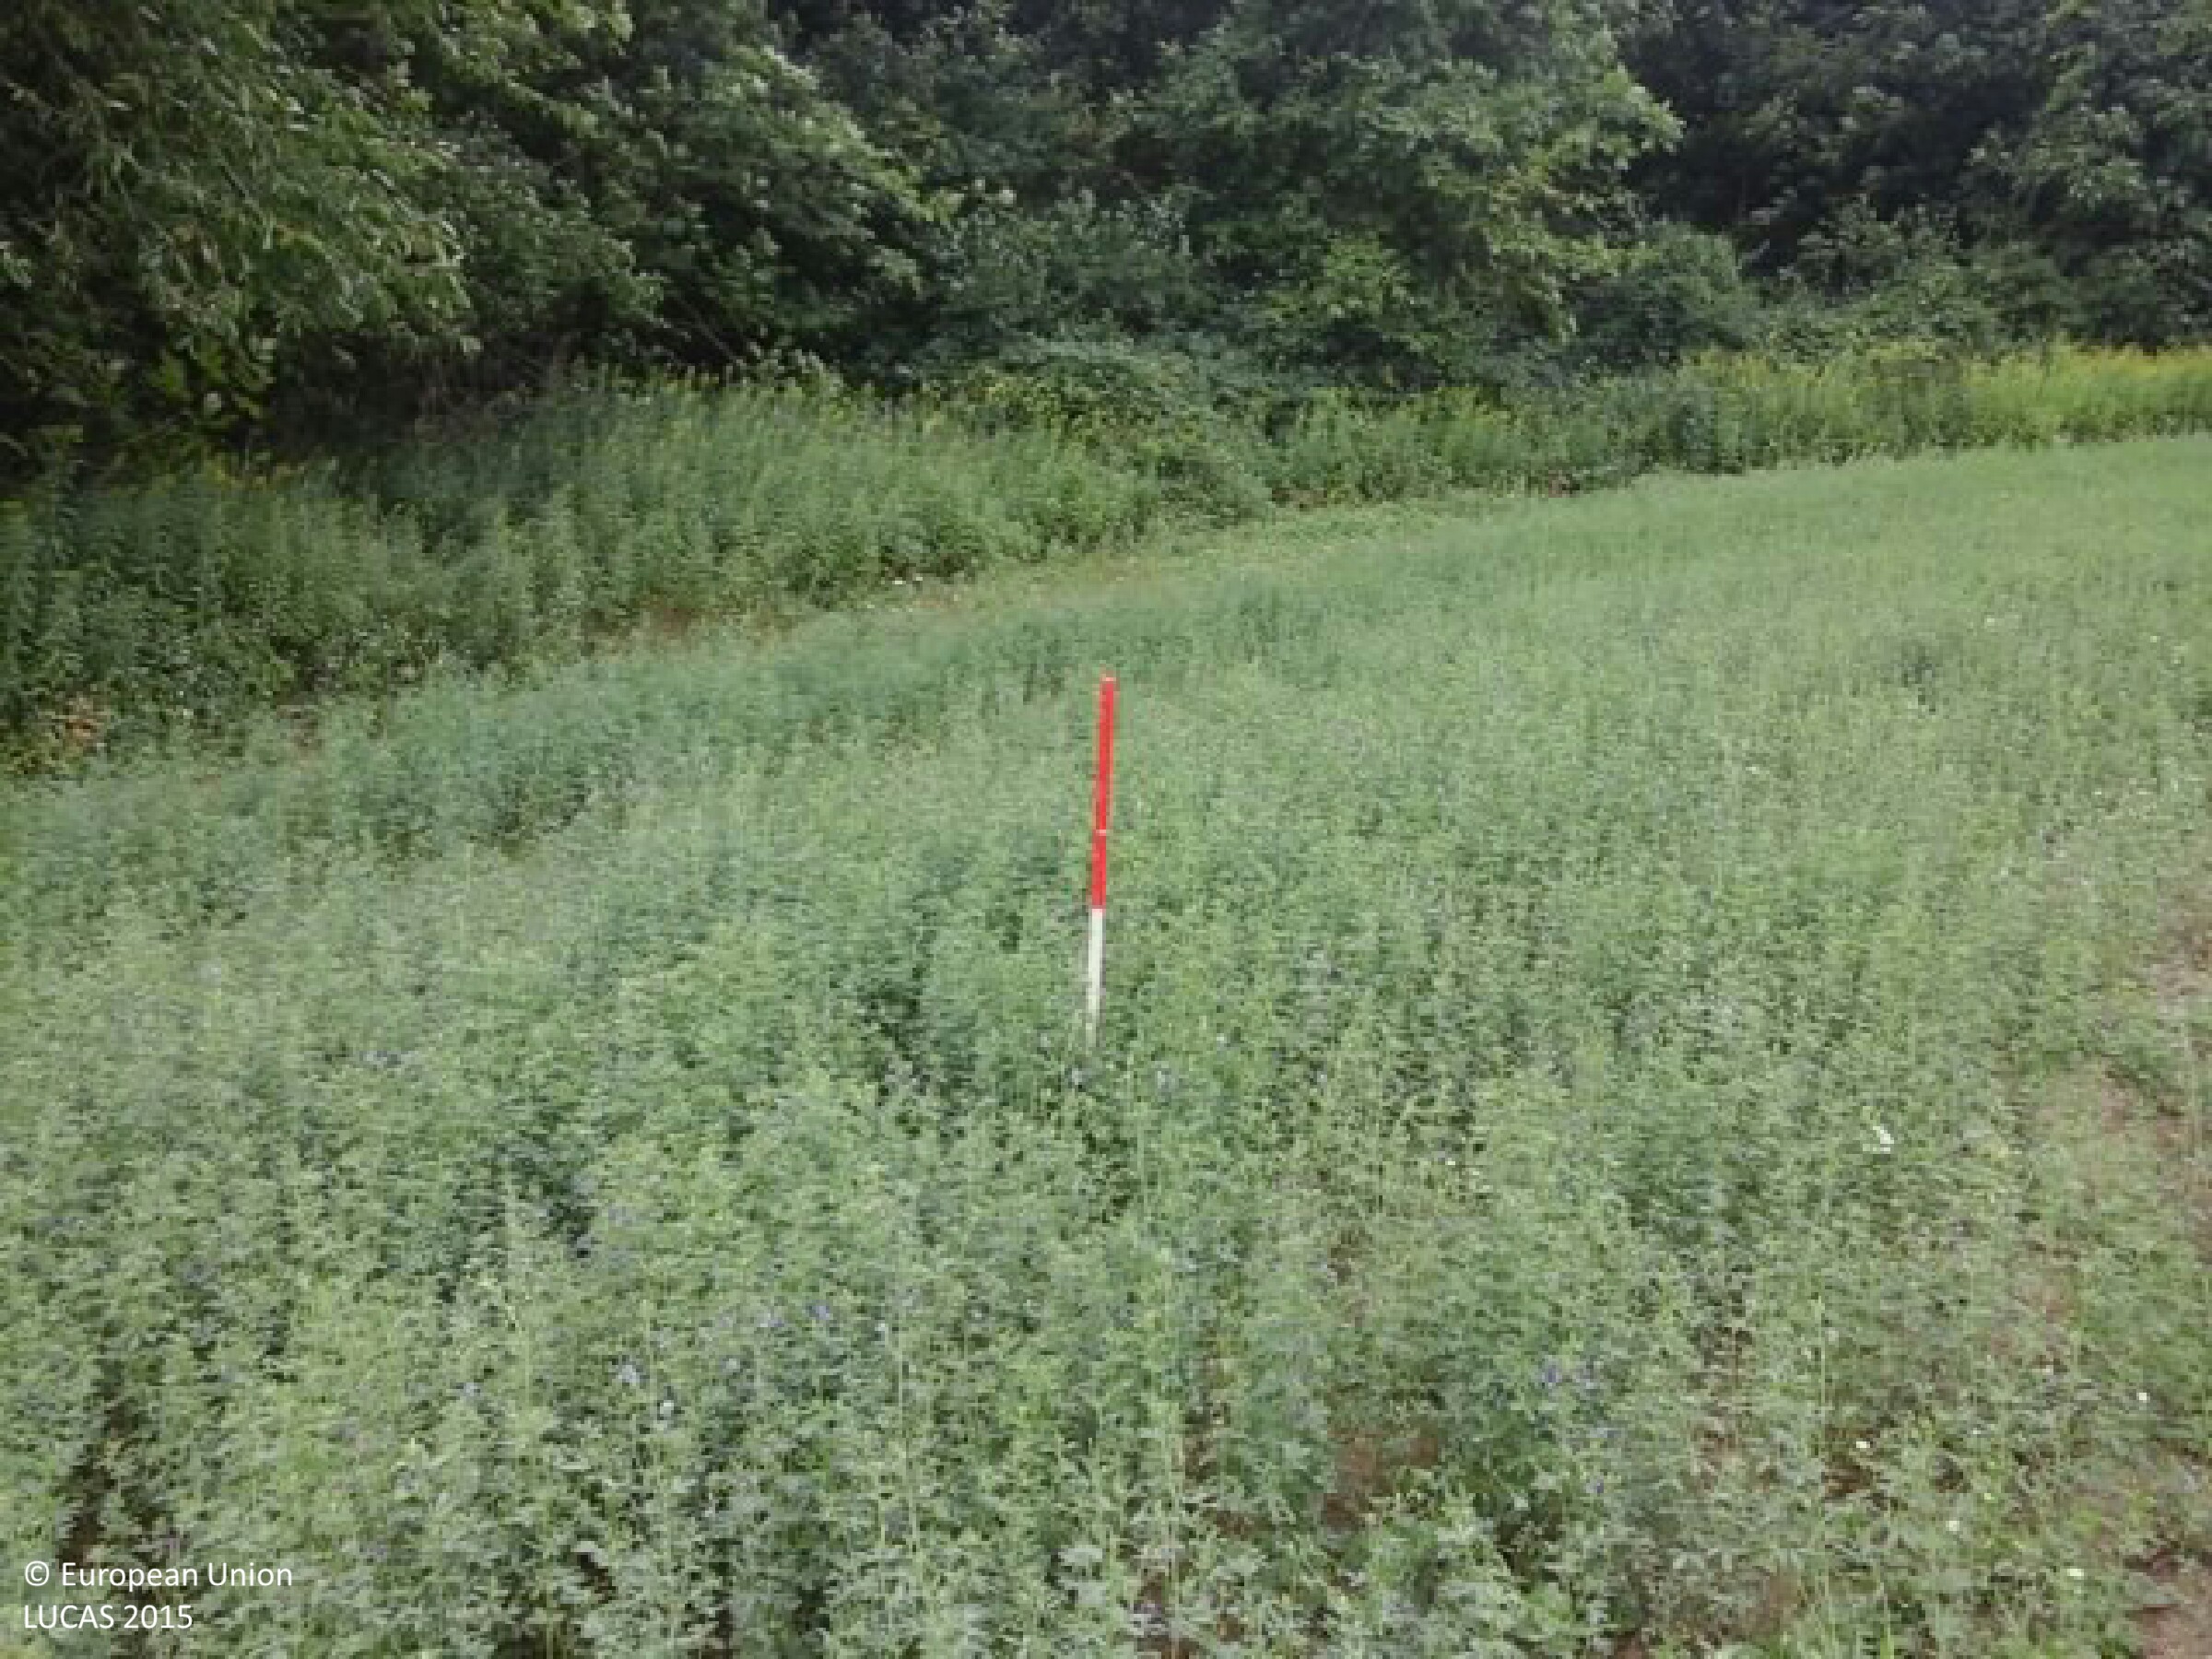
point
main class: Cropland
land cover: Lucerne
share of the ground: > 75 %
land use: Agriculture (excluding fallow land and kitchen gardens)
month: July
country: HU
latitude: 46.2297
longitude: 18.0327
